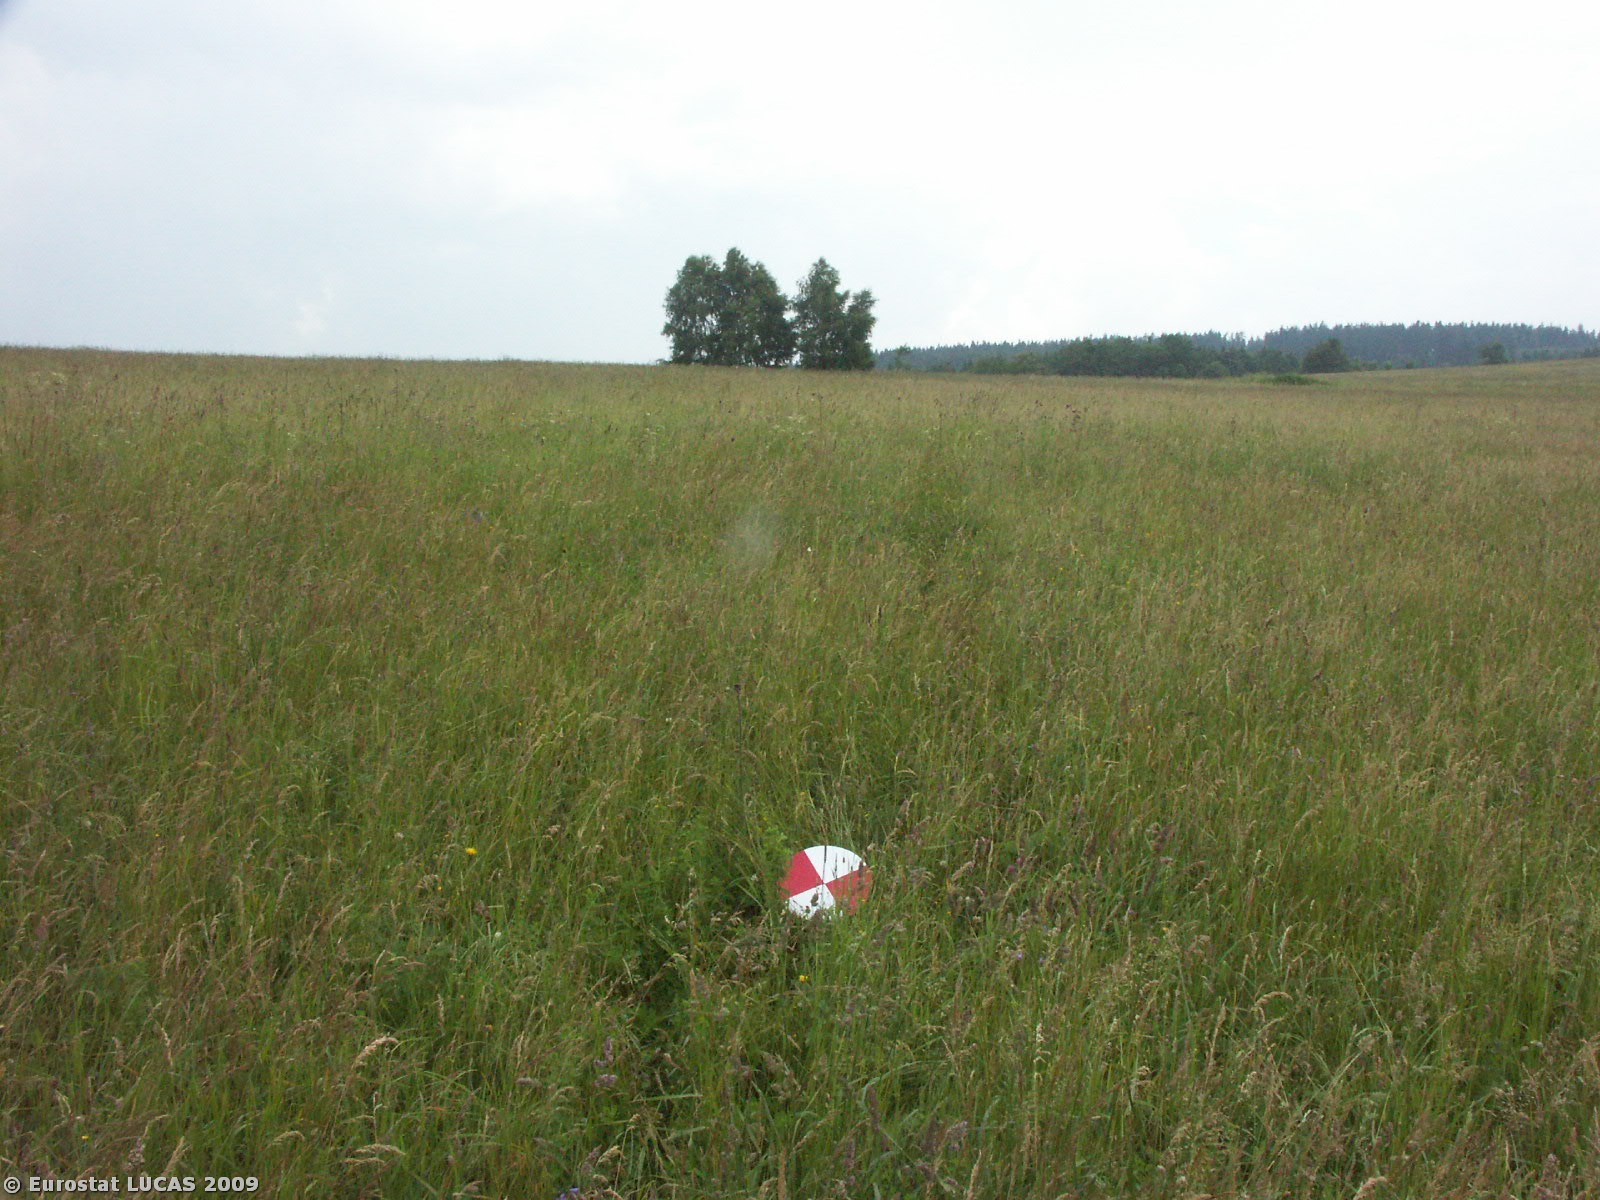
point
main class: Grassland
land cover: Grassland without tree/shrub cover
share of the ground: > 75 %
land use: Agriculture (excluding fallow land and kitchen gardens)
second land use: Nature reserves
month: June
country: CZ
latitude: 49.9554
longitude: 17.2169
